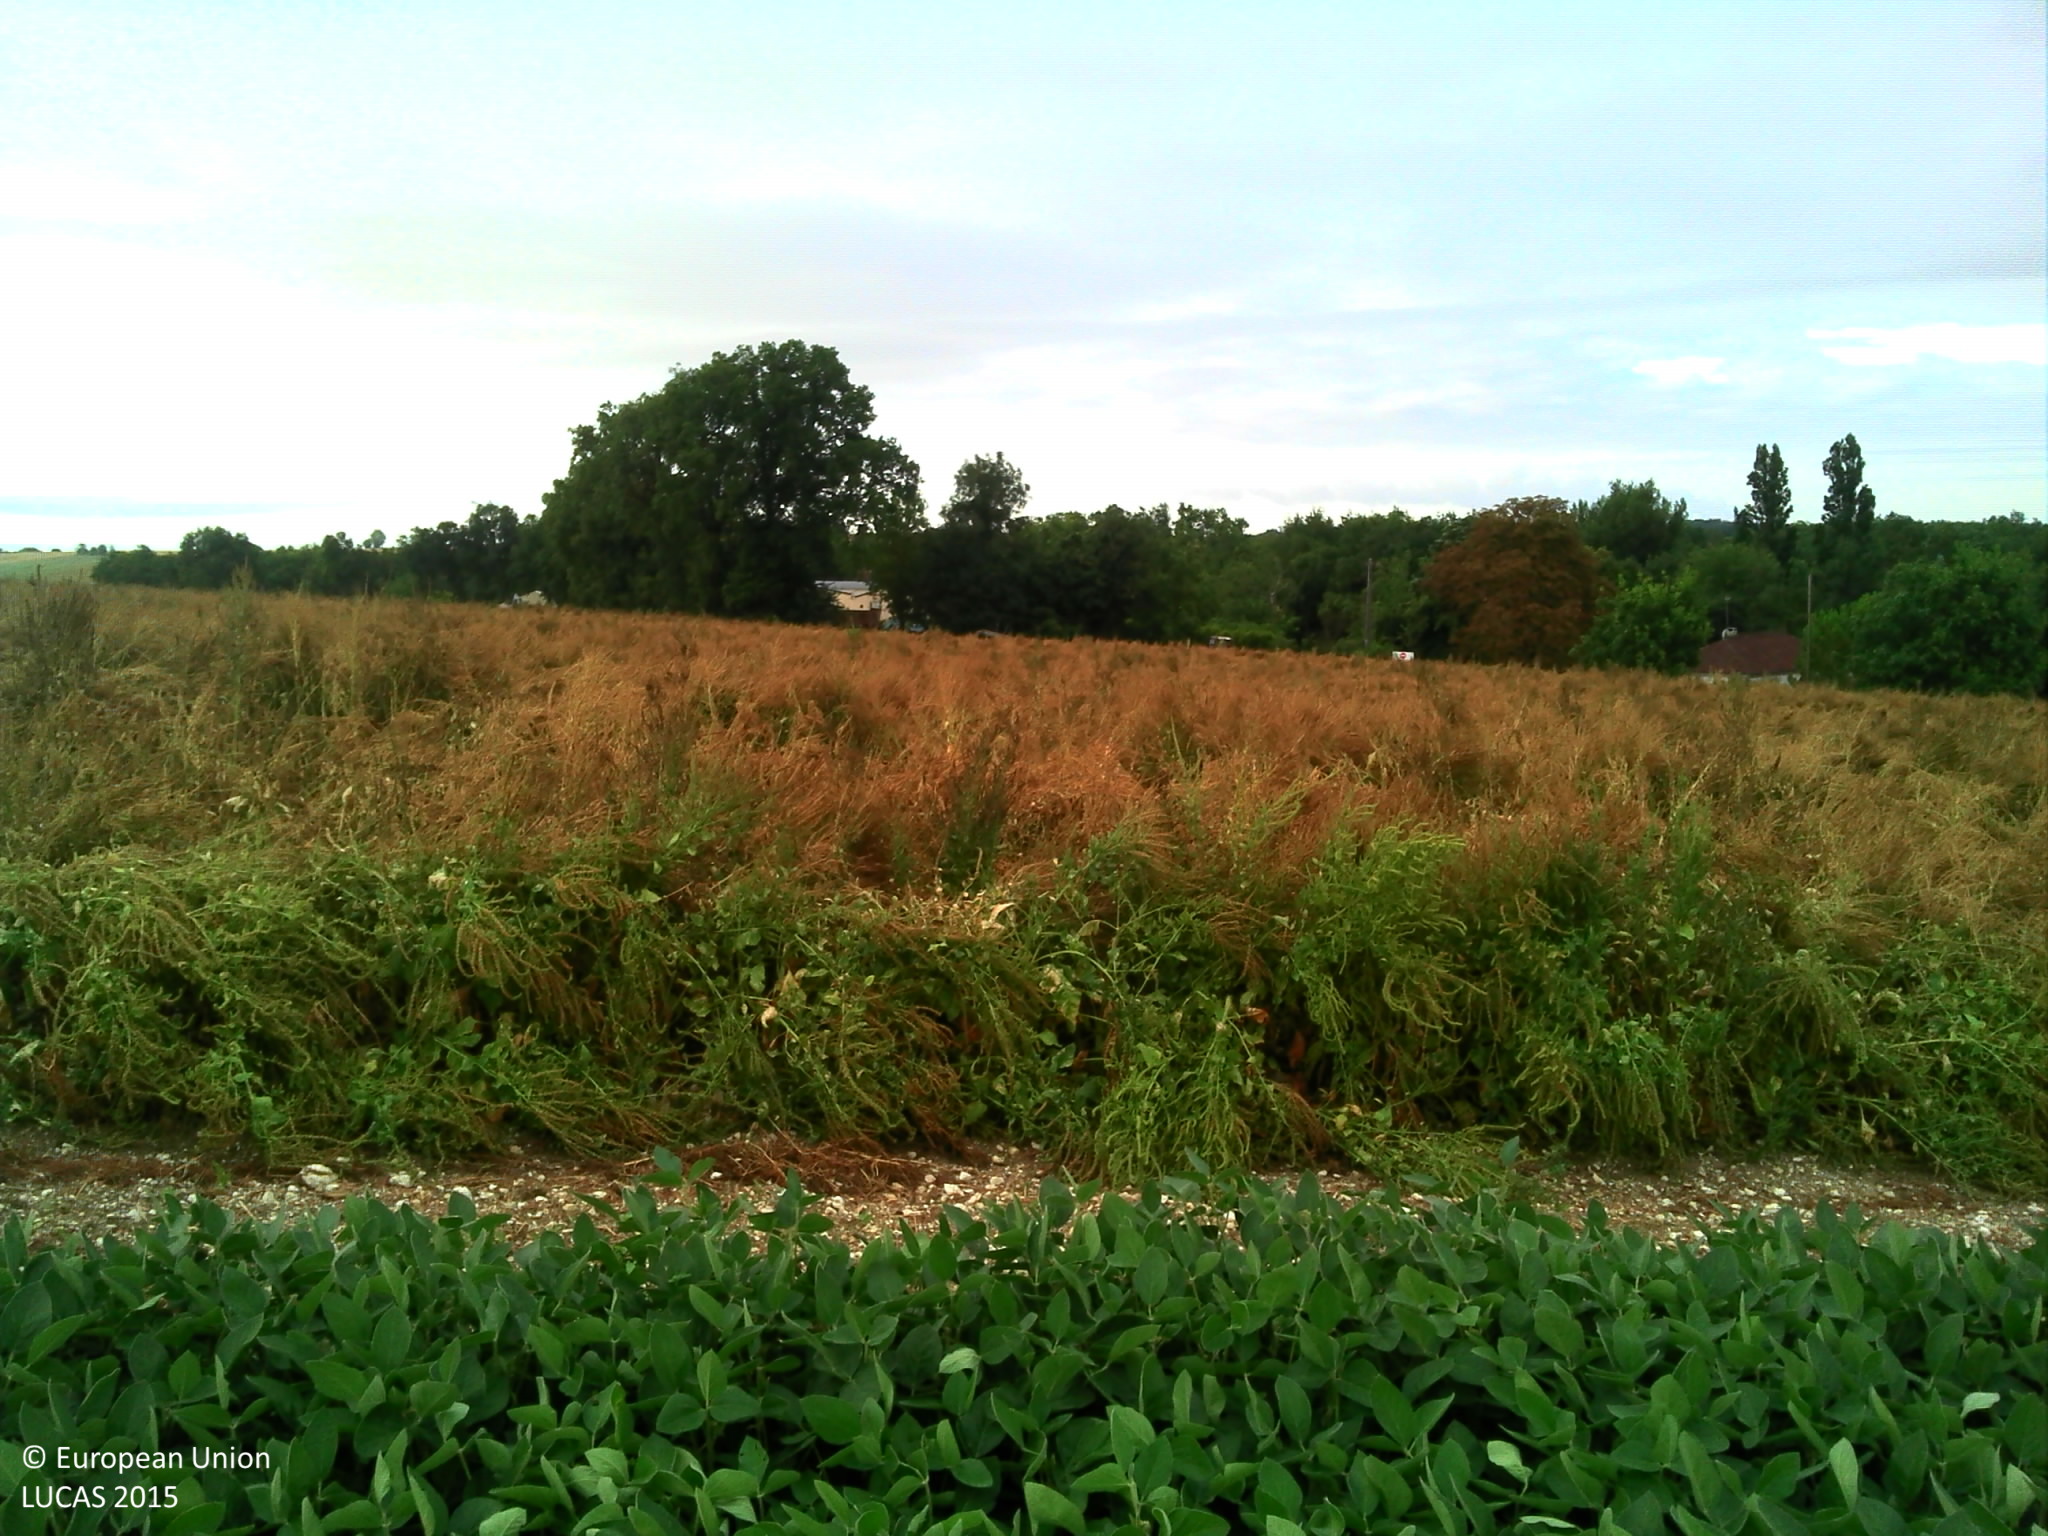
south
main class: Cropland
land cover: Soya
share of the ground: > 75 %
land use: Agriculture (excluding fallow land and kitchen gardens)
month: July
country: FR
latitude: 44.2576
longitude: 0.8902
